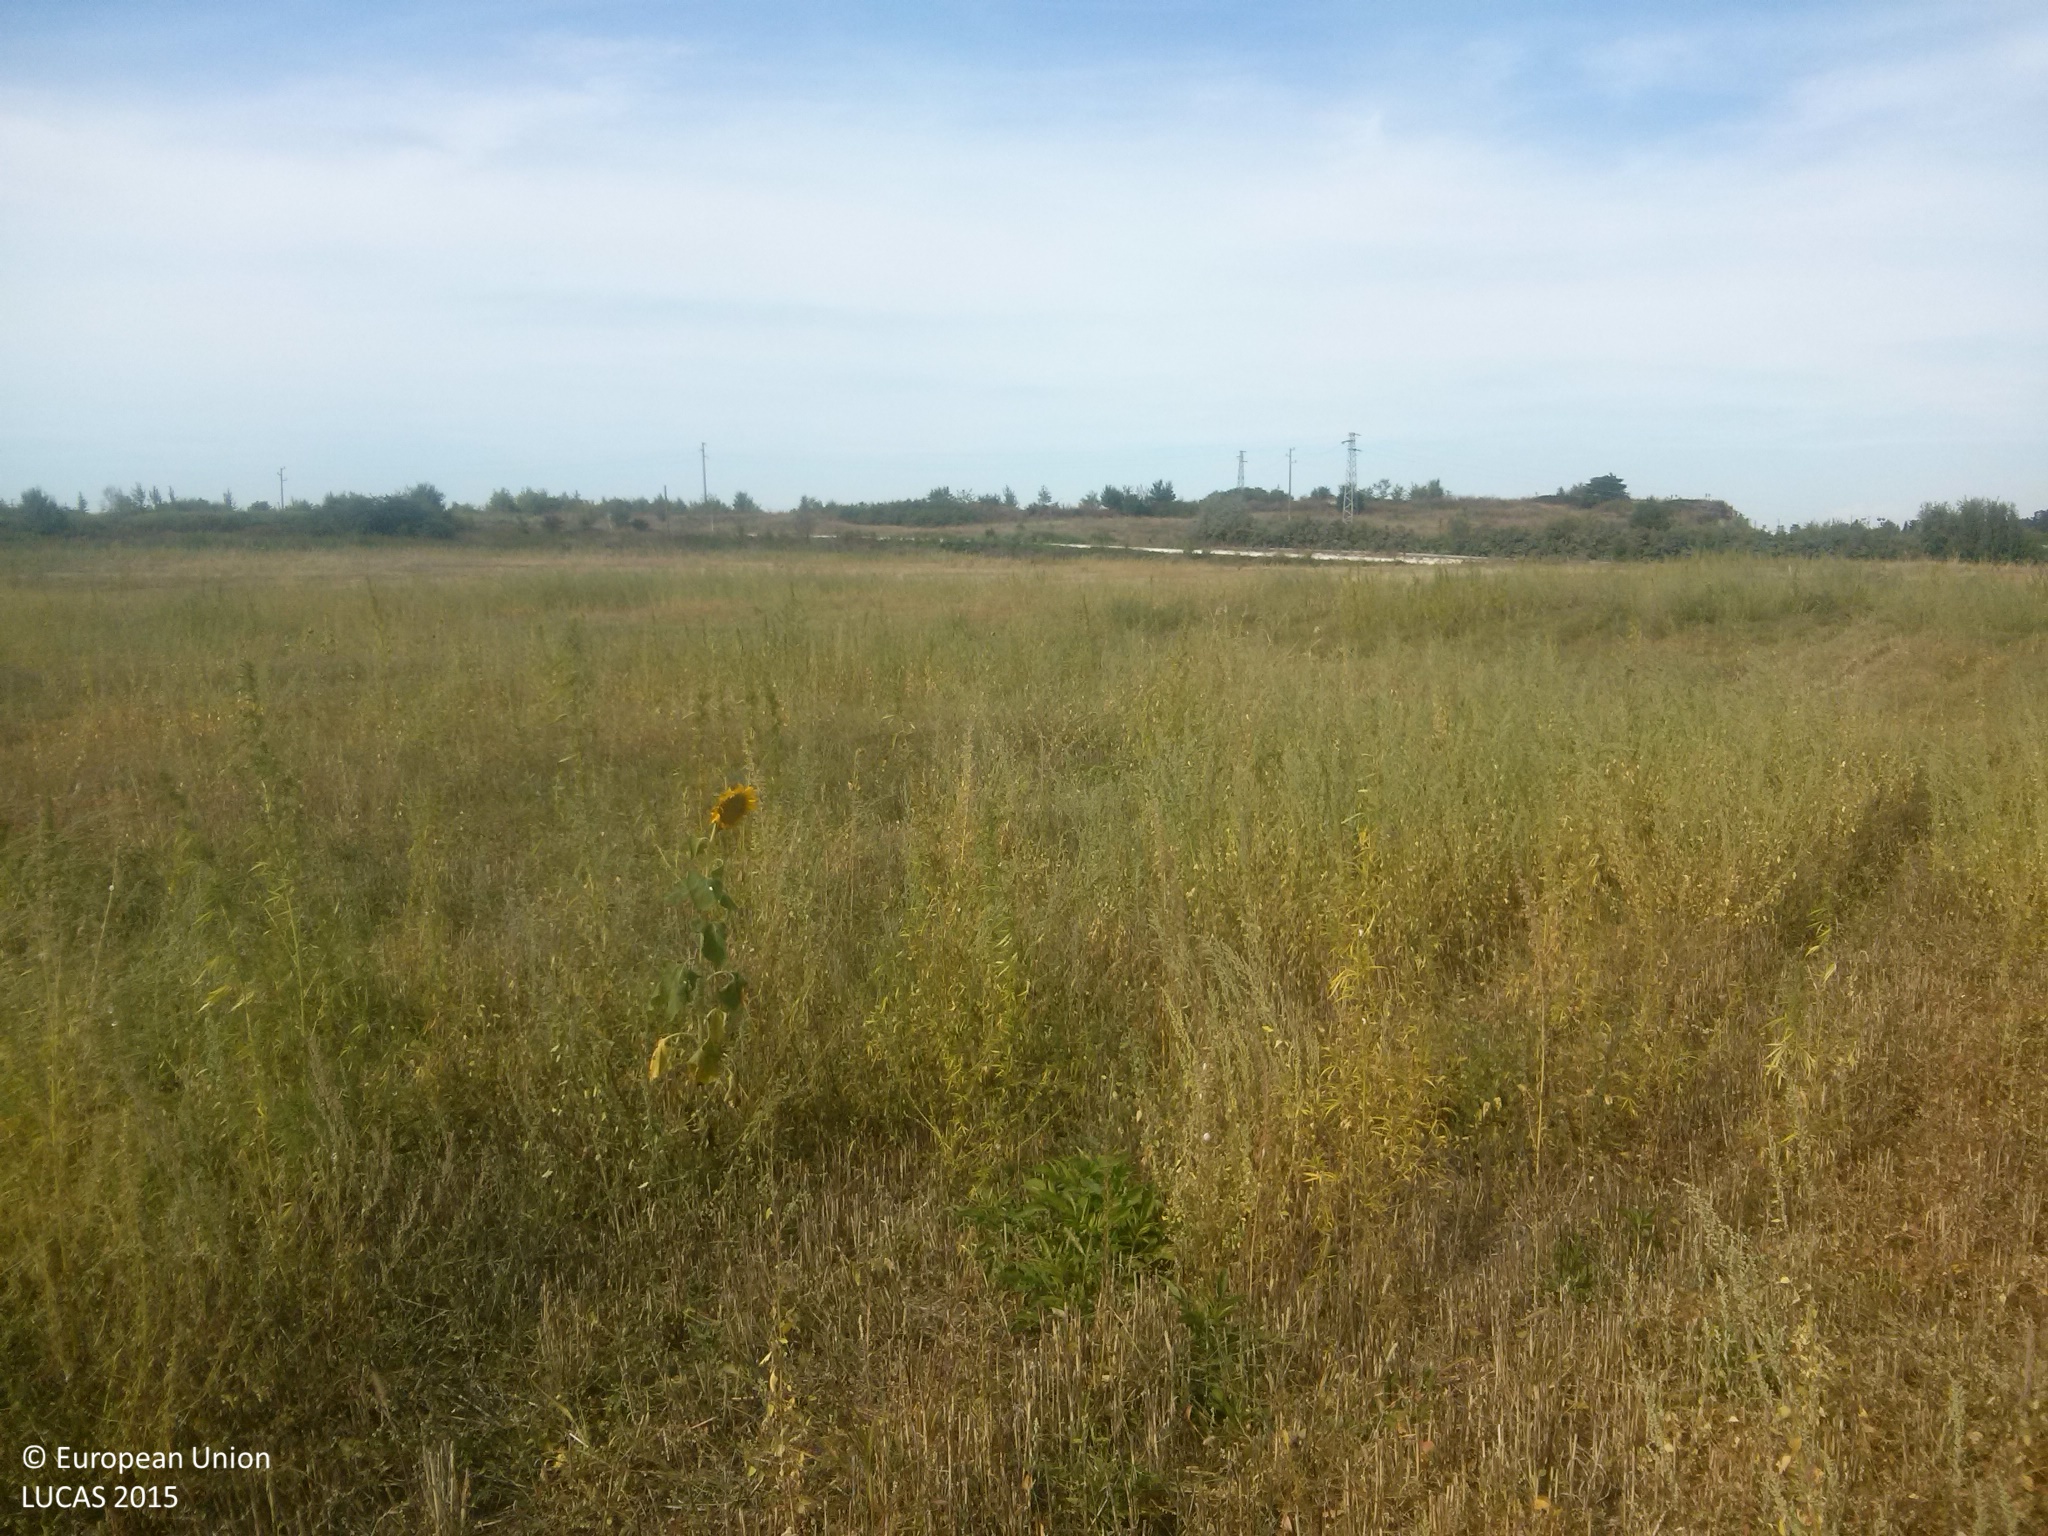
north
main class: Cropland
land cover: Common wheat
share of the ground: 25 - 50 %
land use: Agriculture (excluding fallow land and kitchen gardens)
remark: Harvested field
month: September
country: BG
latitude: 43.6855
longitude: 26.2400
